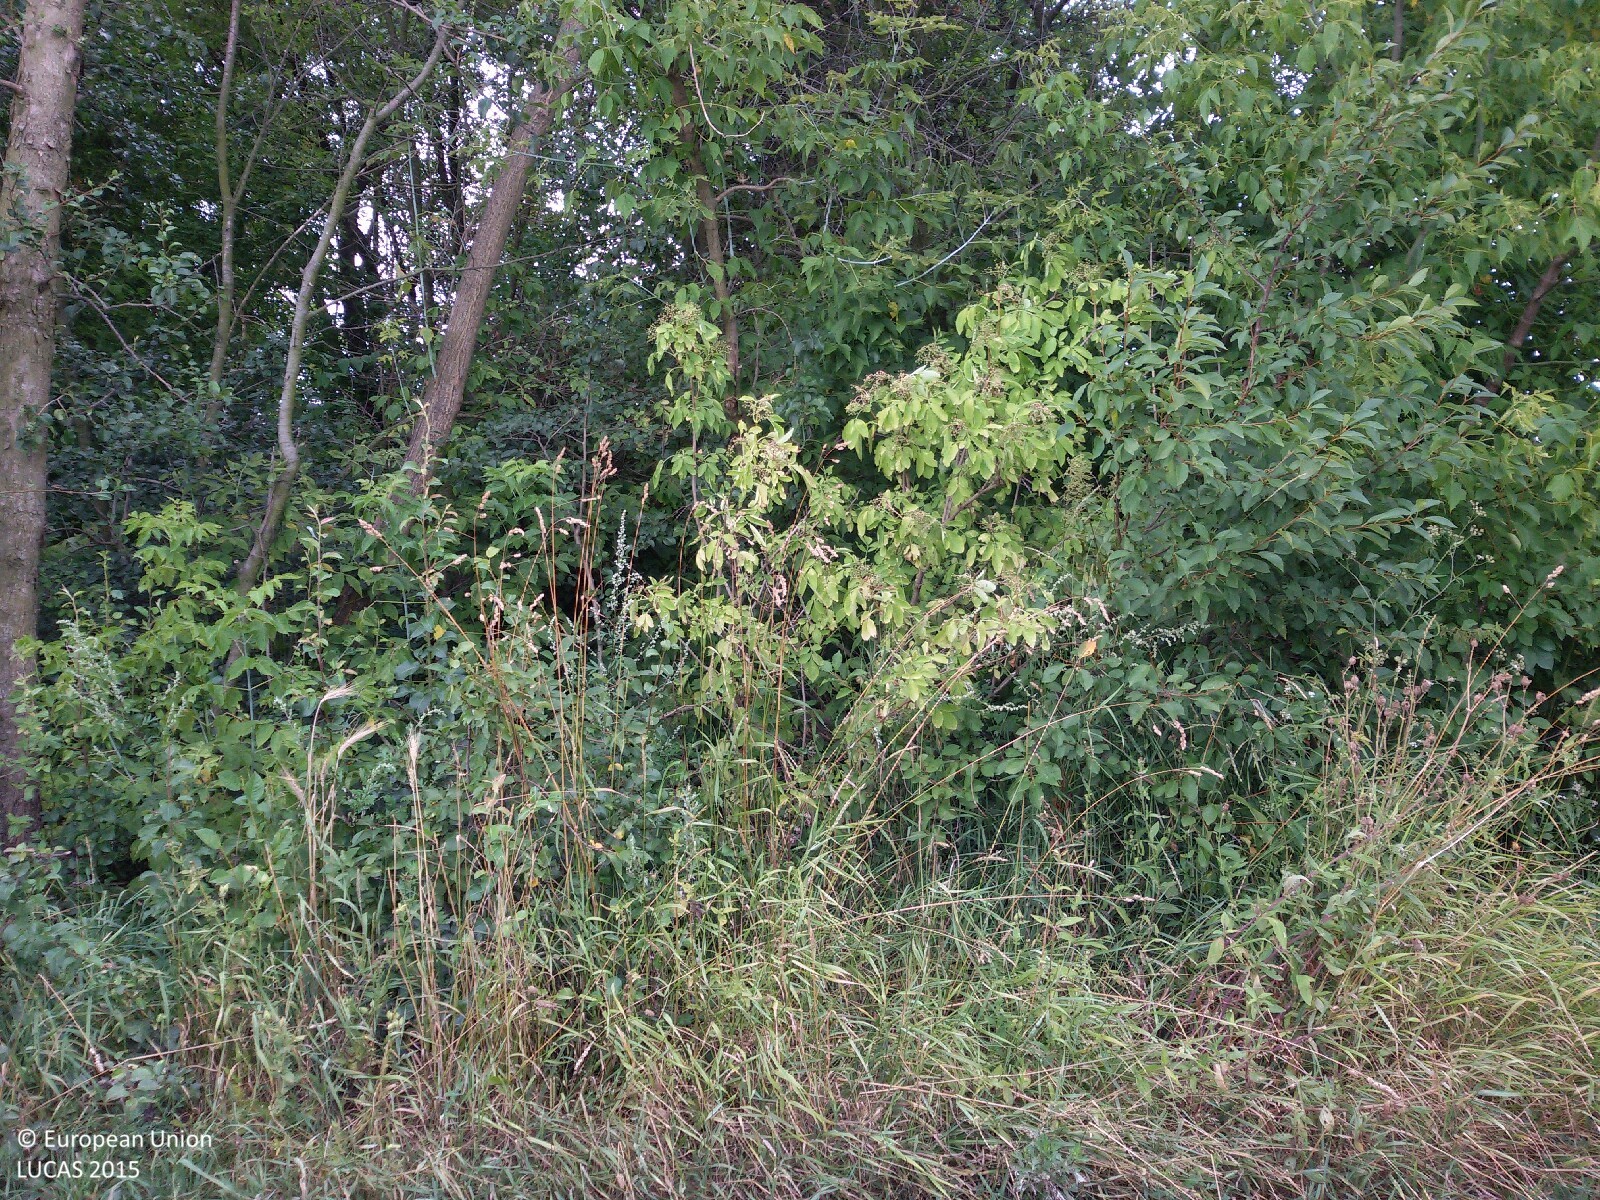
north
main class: Cropland
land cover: Maize
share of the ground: > 75 %
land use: Agriculture (excluding fallow land and kitchen gardens)
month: July
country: PL
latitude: 51.8499
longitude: 21.7115
